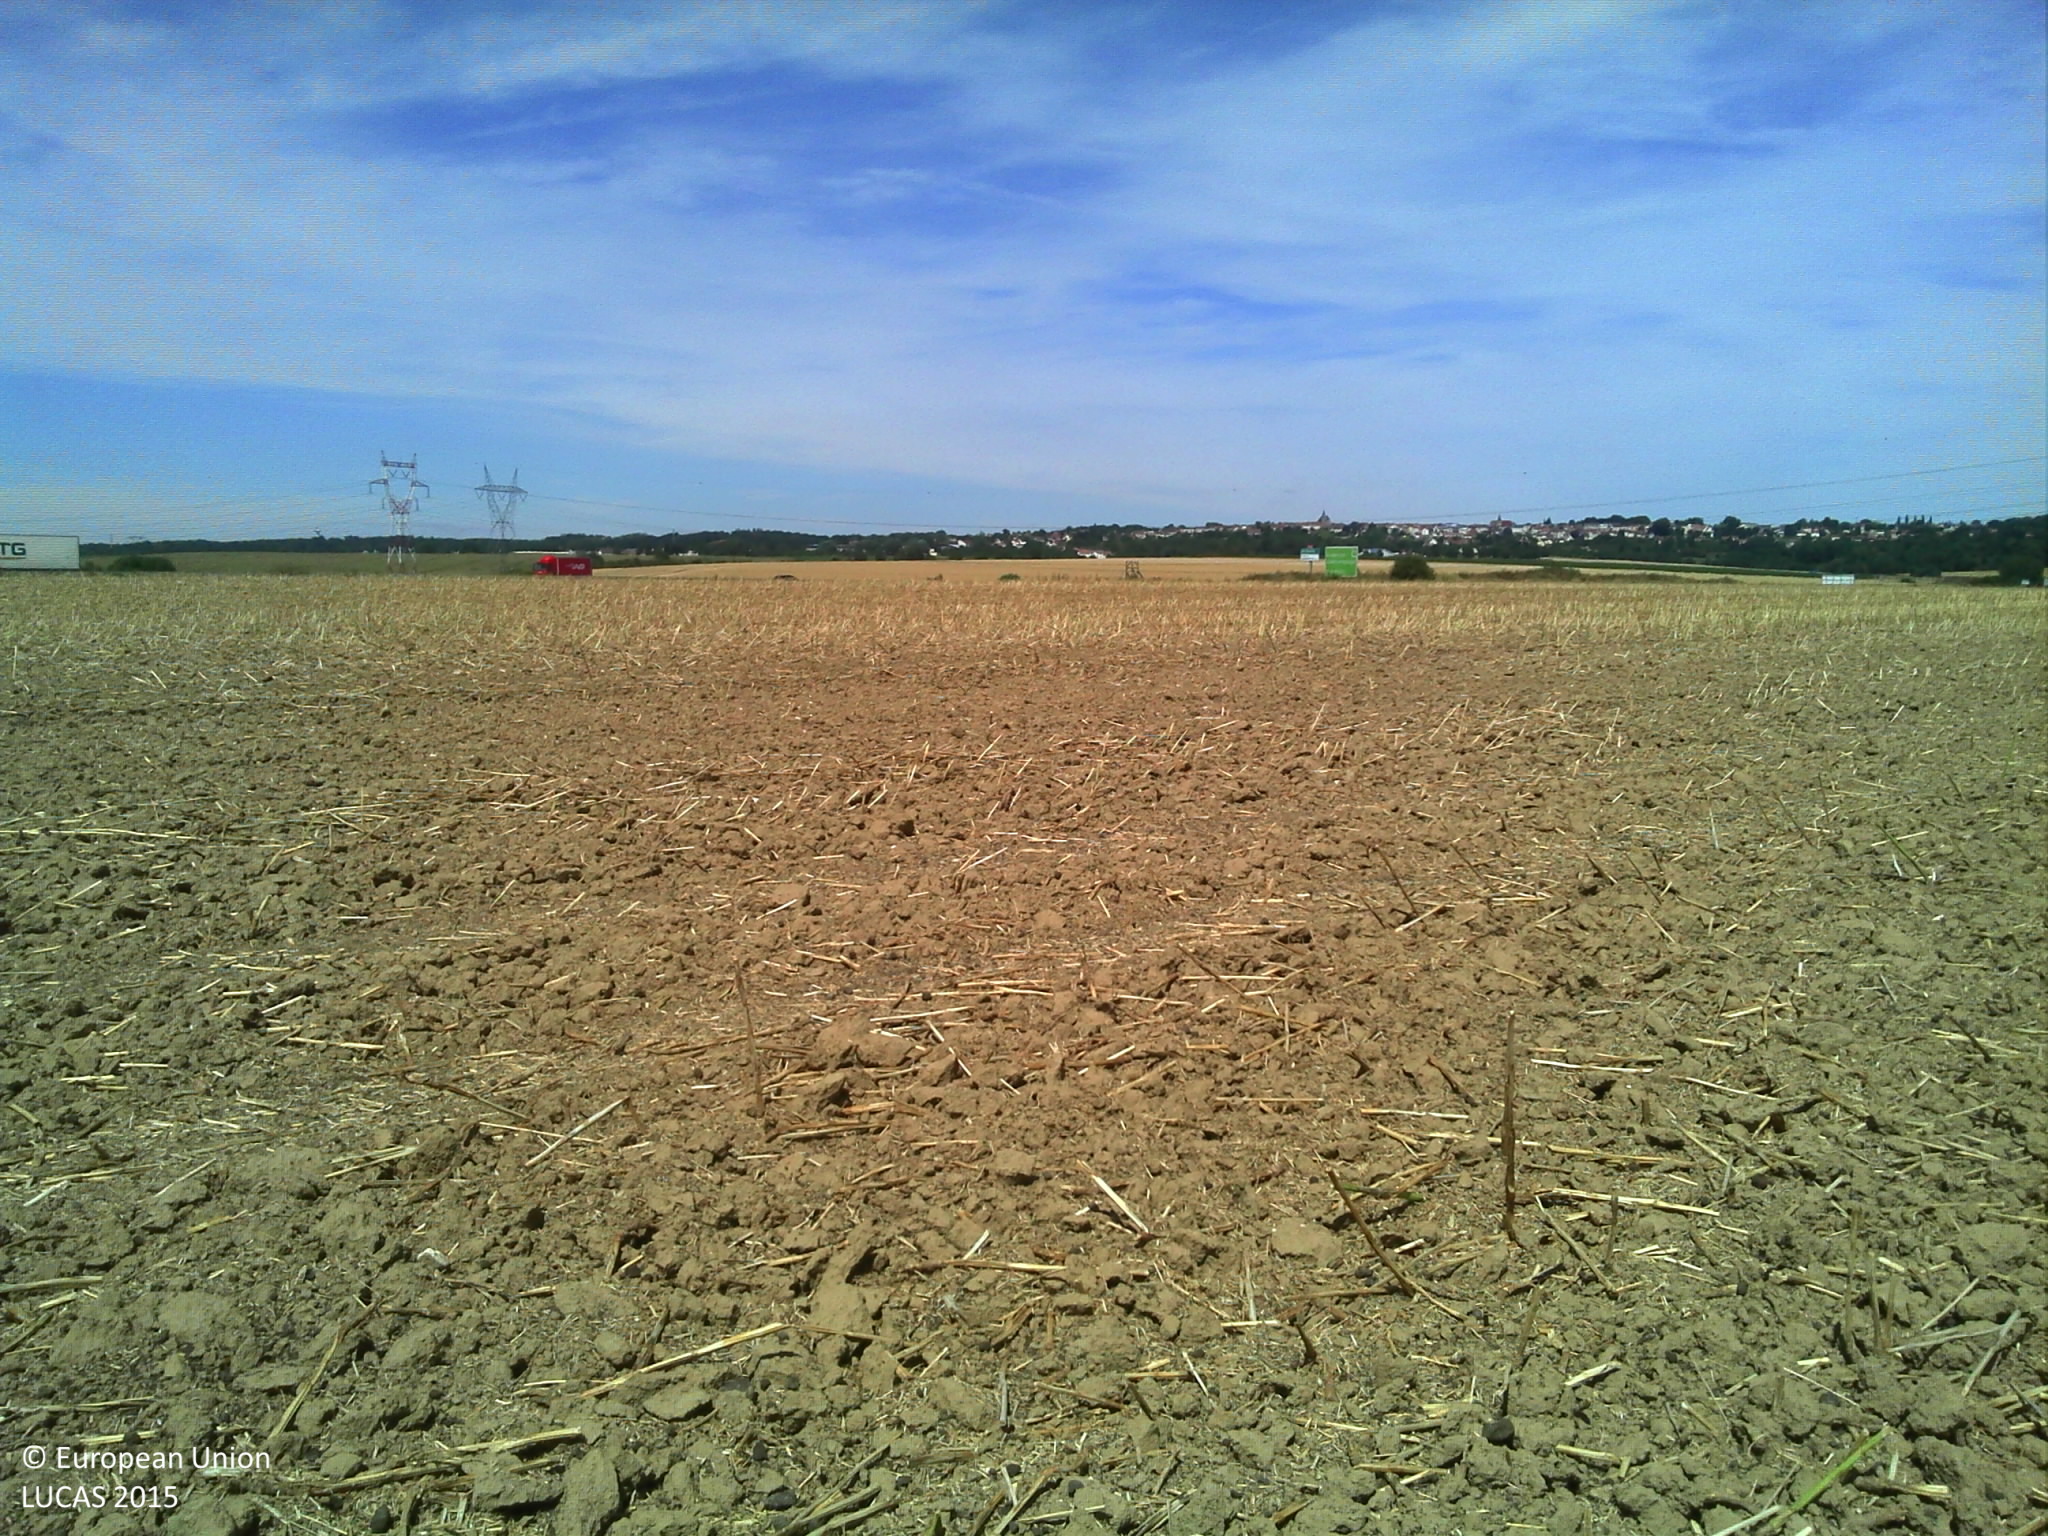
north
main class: Cropland
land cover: Rape and turnip rape
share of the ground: > 75 %
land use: Agriculture (excluding fallow land and kitchen gardens)
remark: Harvested field
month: August
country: FR
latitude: 49.0273
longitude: 2.6726
